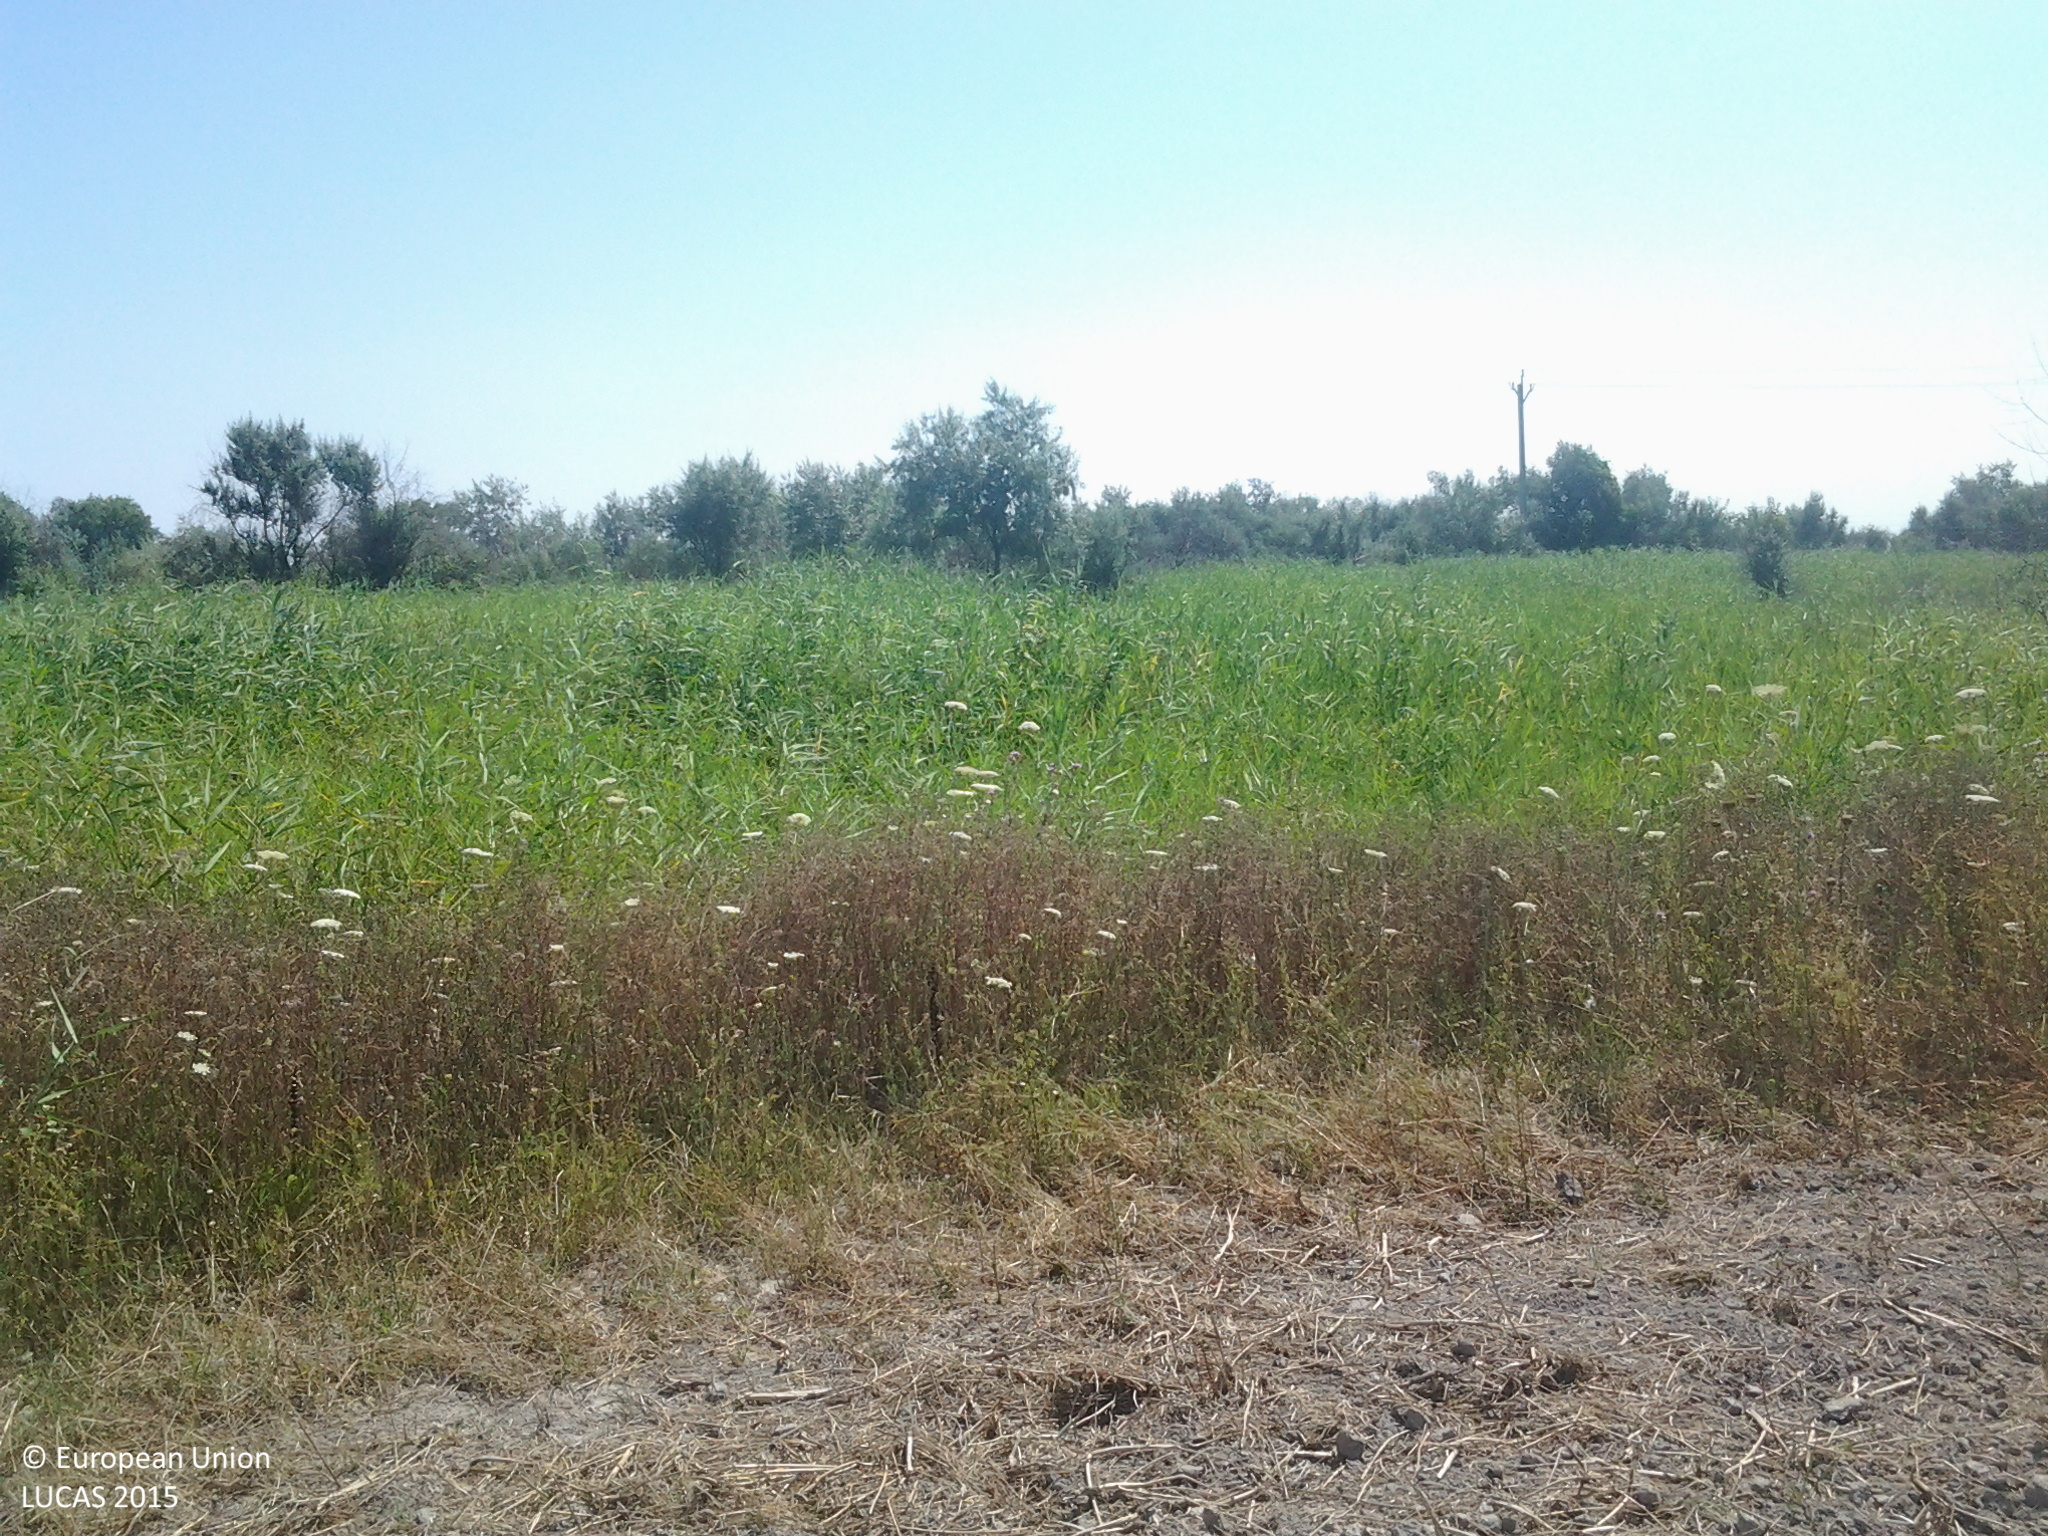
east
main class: Cropland
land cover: Rape and turnip rape
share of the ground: < 10 %
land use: Agriculture (excluding fallow land and kitchen gardens)
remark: Harvested field
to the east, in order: Rape and turnip rape; Spontaneously vegetated surfaces; Shrubland with sparse tree cover; Inland marshes; Grassland with sparse tree/shrub cover; Inland marshes; Inland fresh running water; Grassland with sparse tree/shrub cover; Inland marshes; Electric lines; Inland marshes; Electric lines; Inland marshes
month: July
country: HU
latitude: 46.6715
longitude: 19.0733
